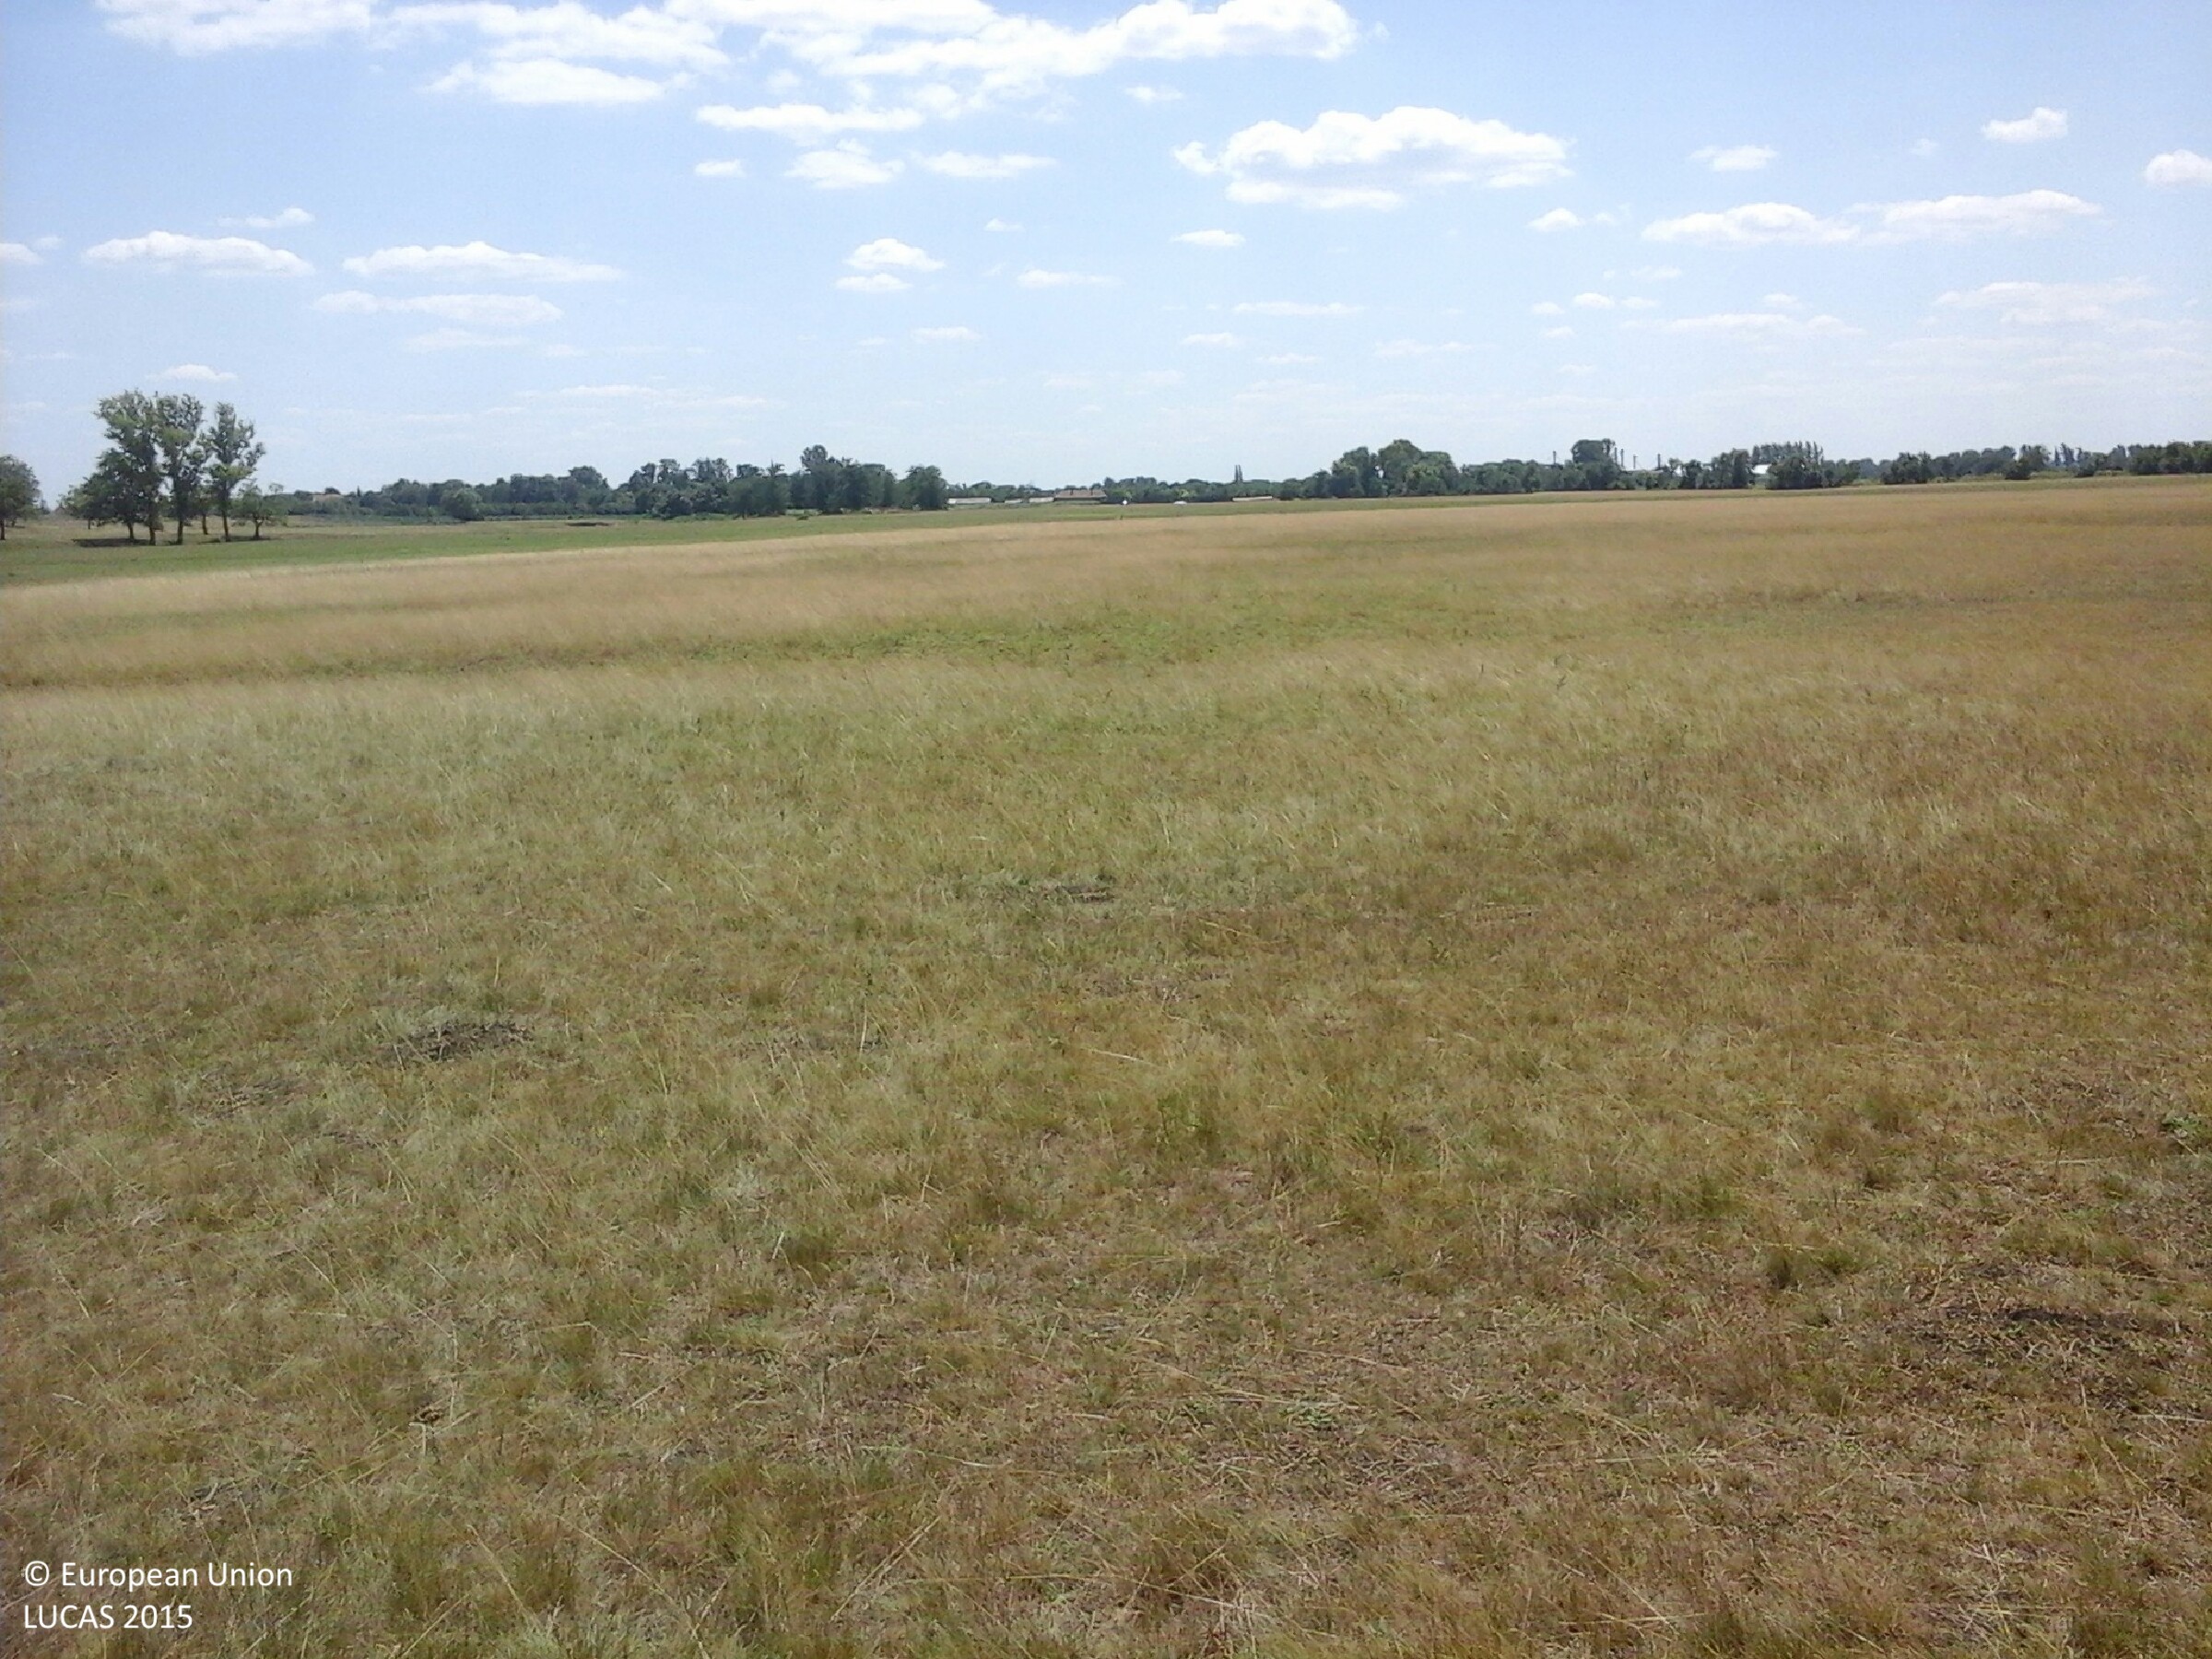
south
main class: Grassland
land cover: Grassland without tree/shrub cover
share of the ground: > 75 %
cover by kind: herbaceous plants 95 %, unconsolidated bare surface 5 %
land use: Agriculture (excluding fallow land and kitchen gardens)
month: July
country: HU
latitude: 47.8479
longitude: 20.6852
